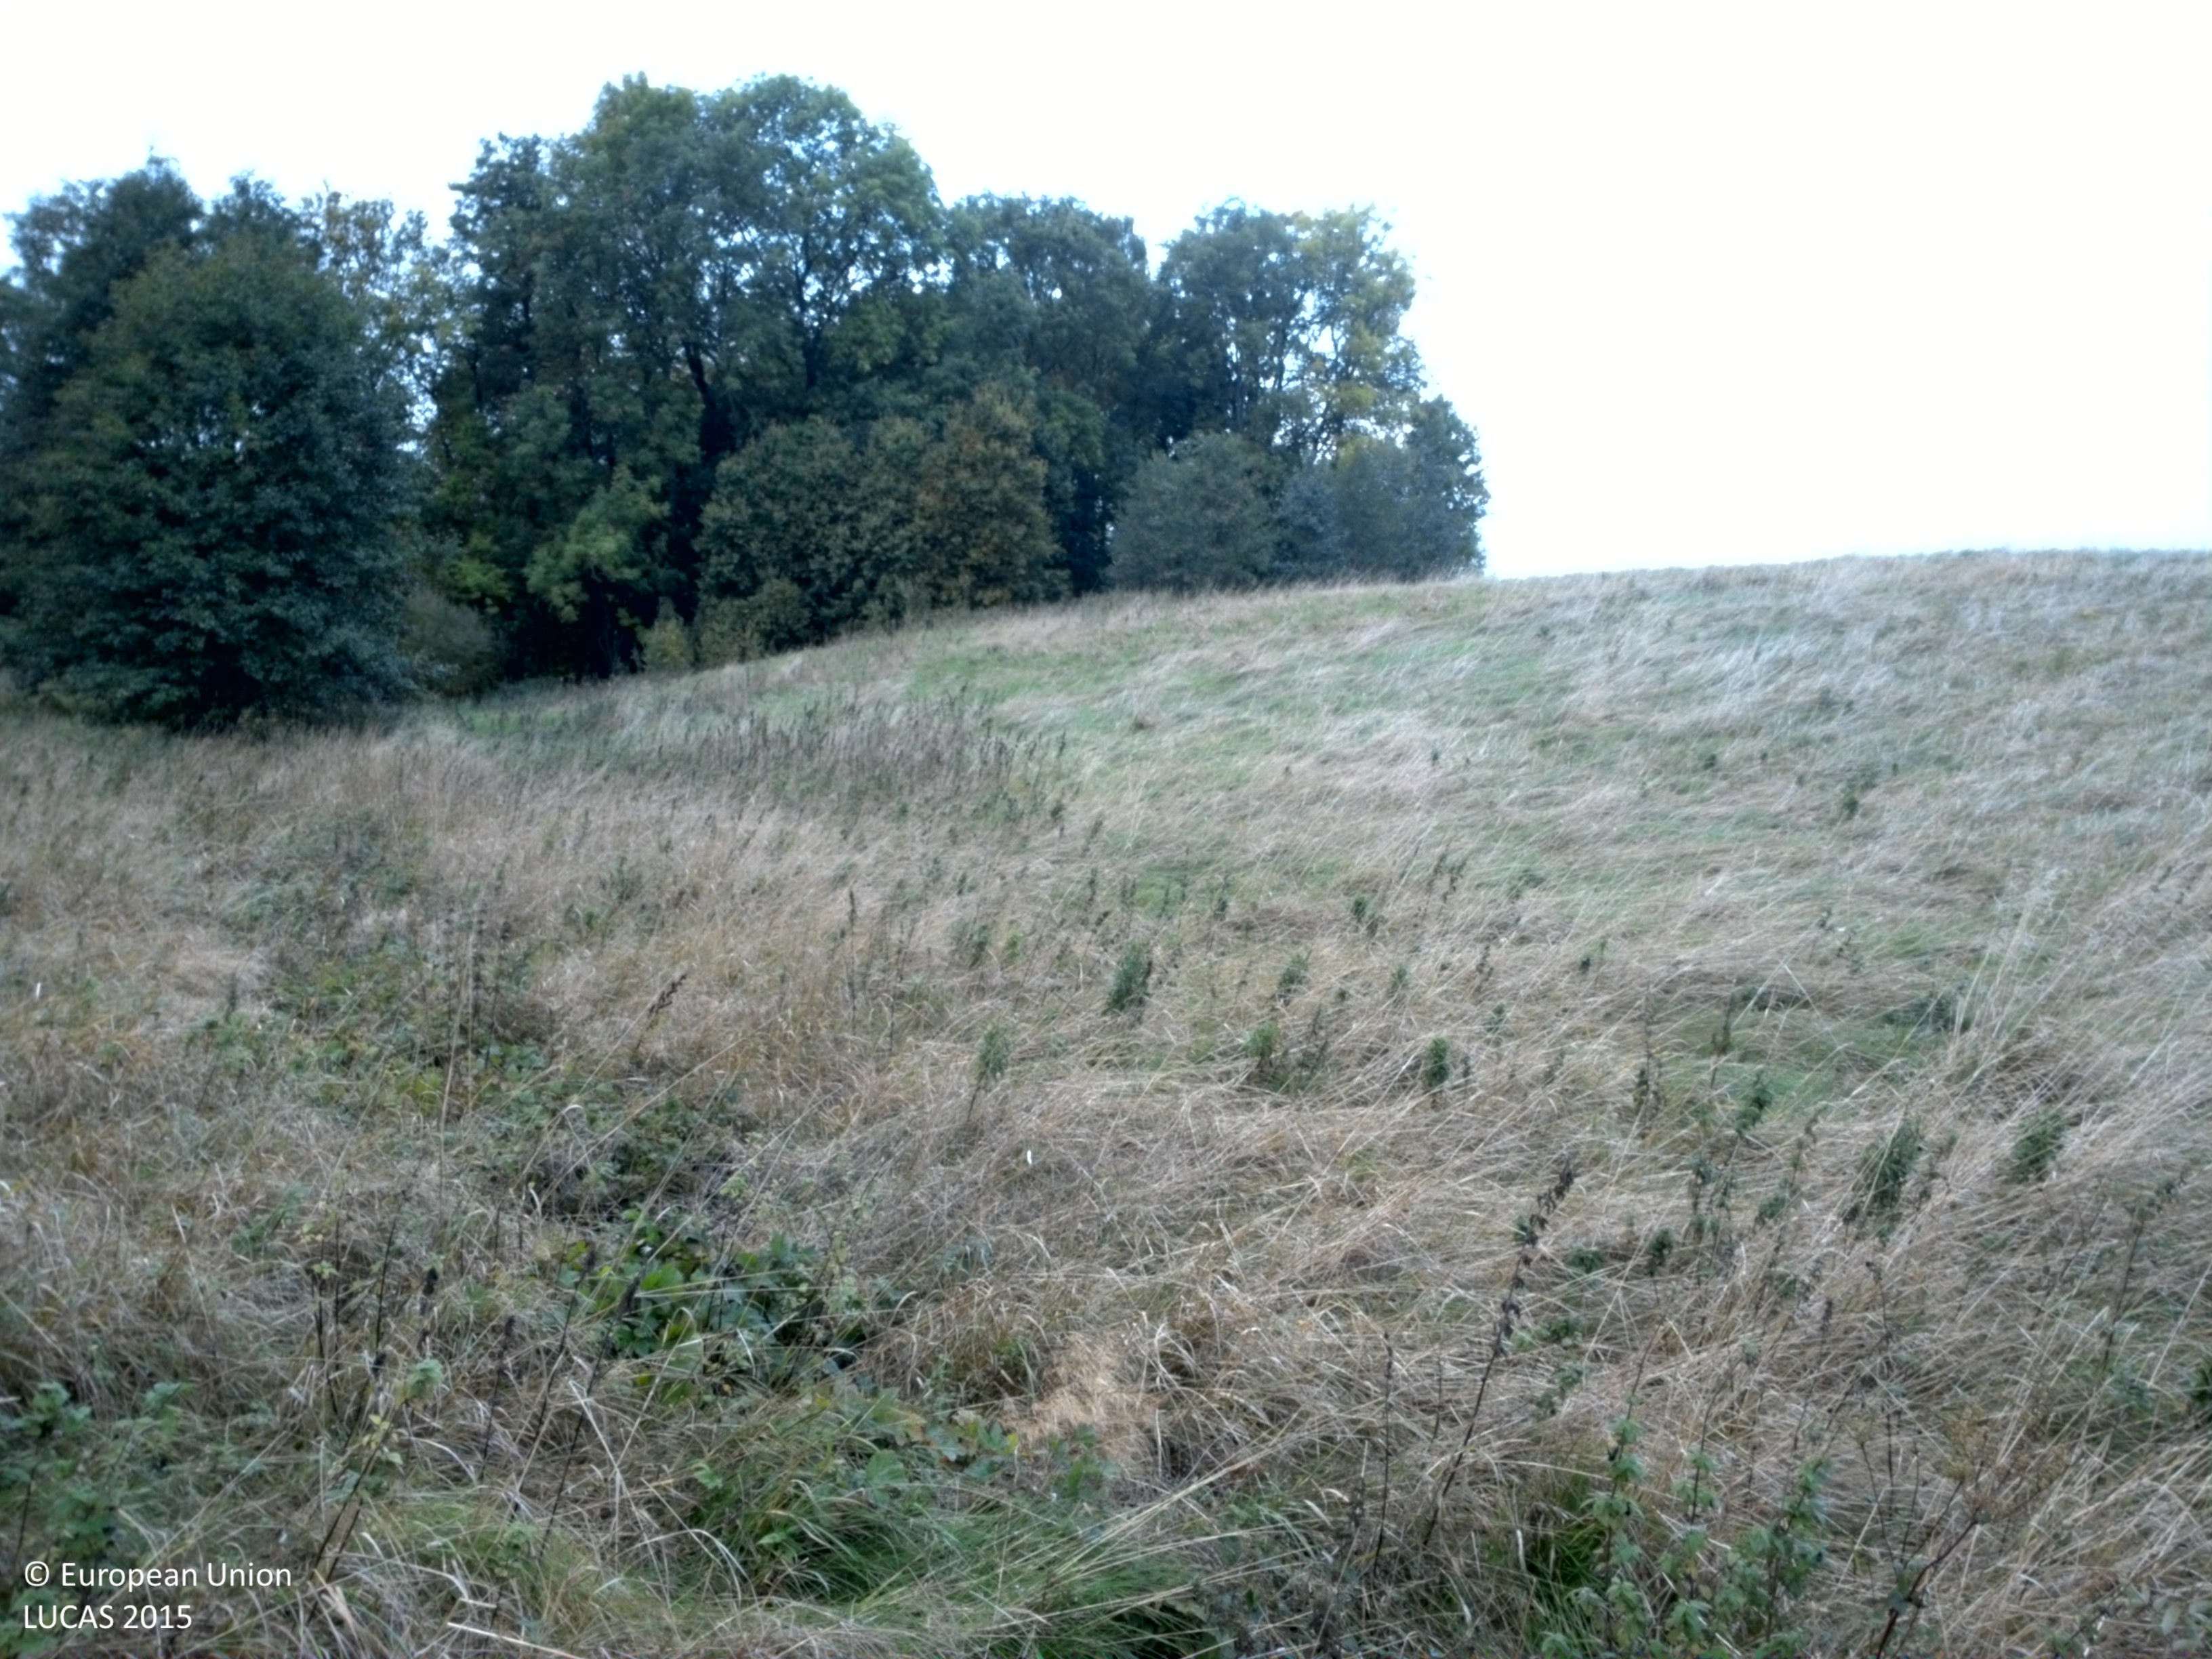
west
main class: Grassland
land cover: Grassland without tree/shrub cover
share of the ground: > 75 %
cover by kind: herbaceous plants 100 %
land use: Semi-natural and natural areas not in use
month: October
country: SE
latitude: 58.3132
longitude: 12.9476
